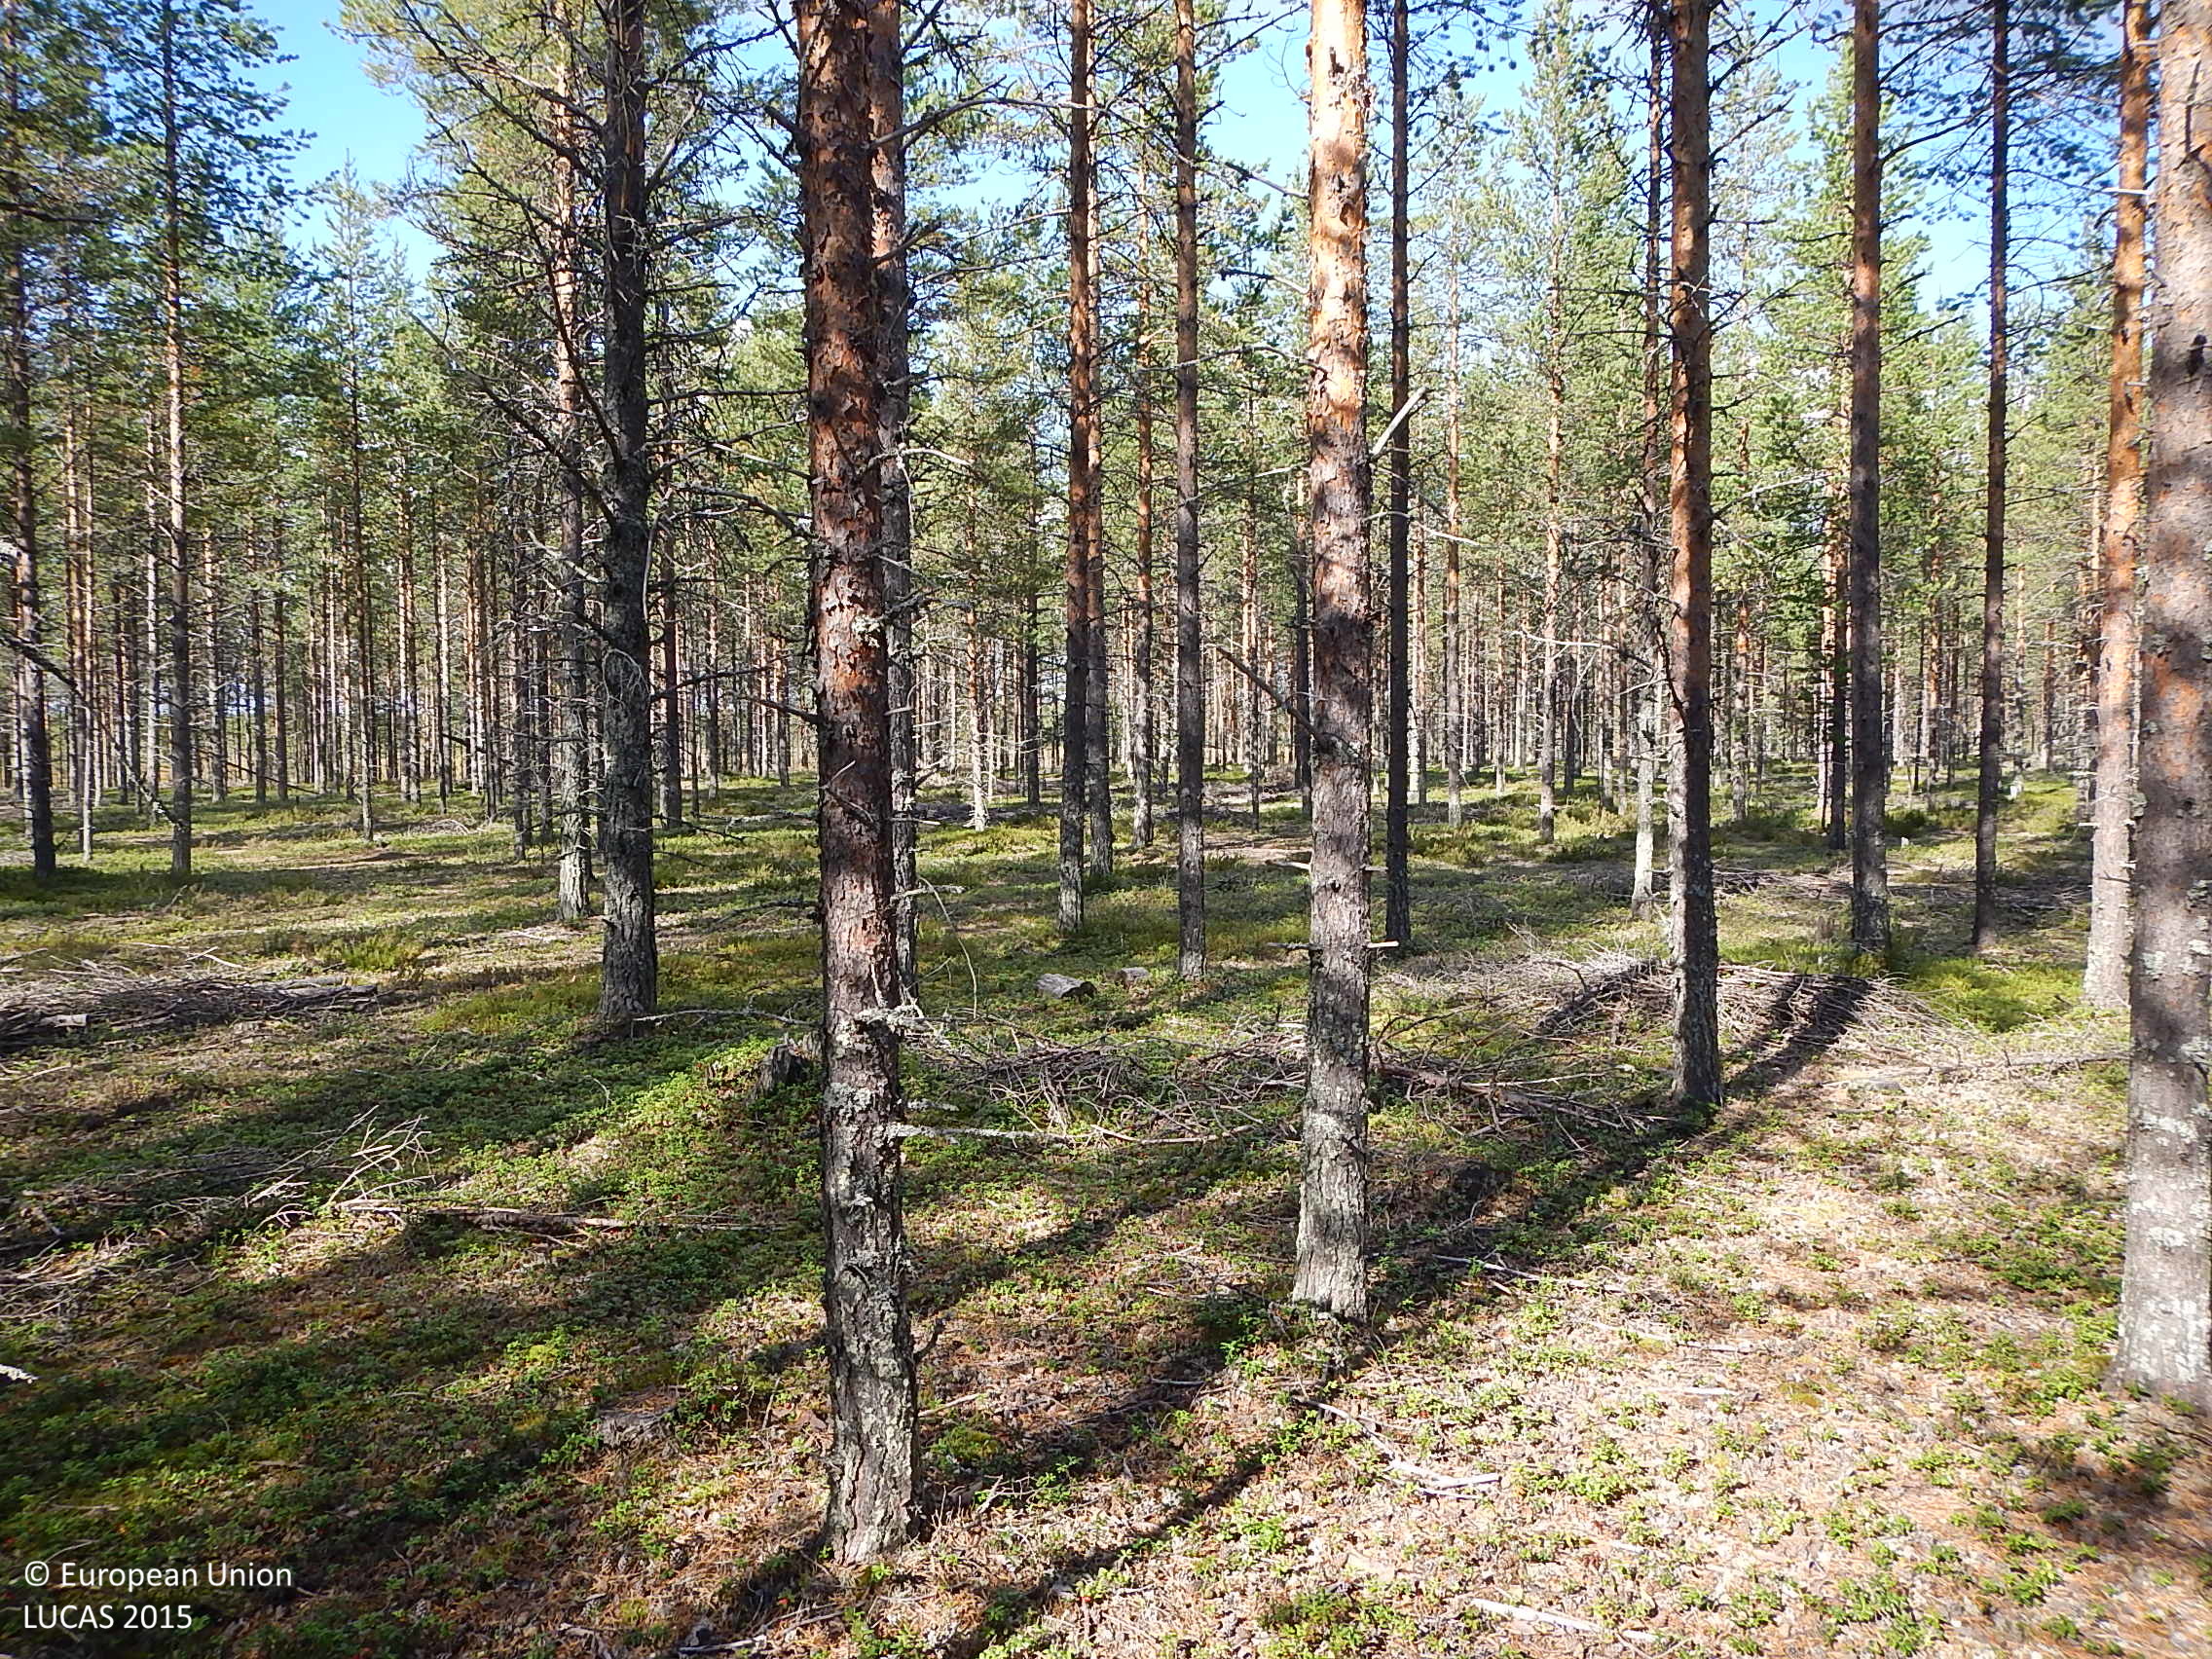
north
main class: Woodland
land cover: Pine dominated coniferous woodland
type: boreal forest
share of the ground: 50 - 75 %
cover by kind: coniferous forest trees 70 %, shrubs 20 %, herbaceous plants 10 %
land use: Forestry
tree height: > 5 m
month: August
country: FI
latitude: 65.3928
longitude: 26.9237
